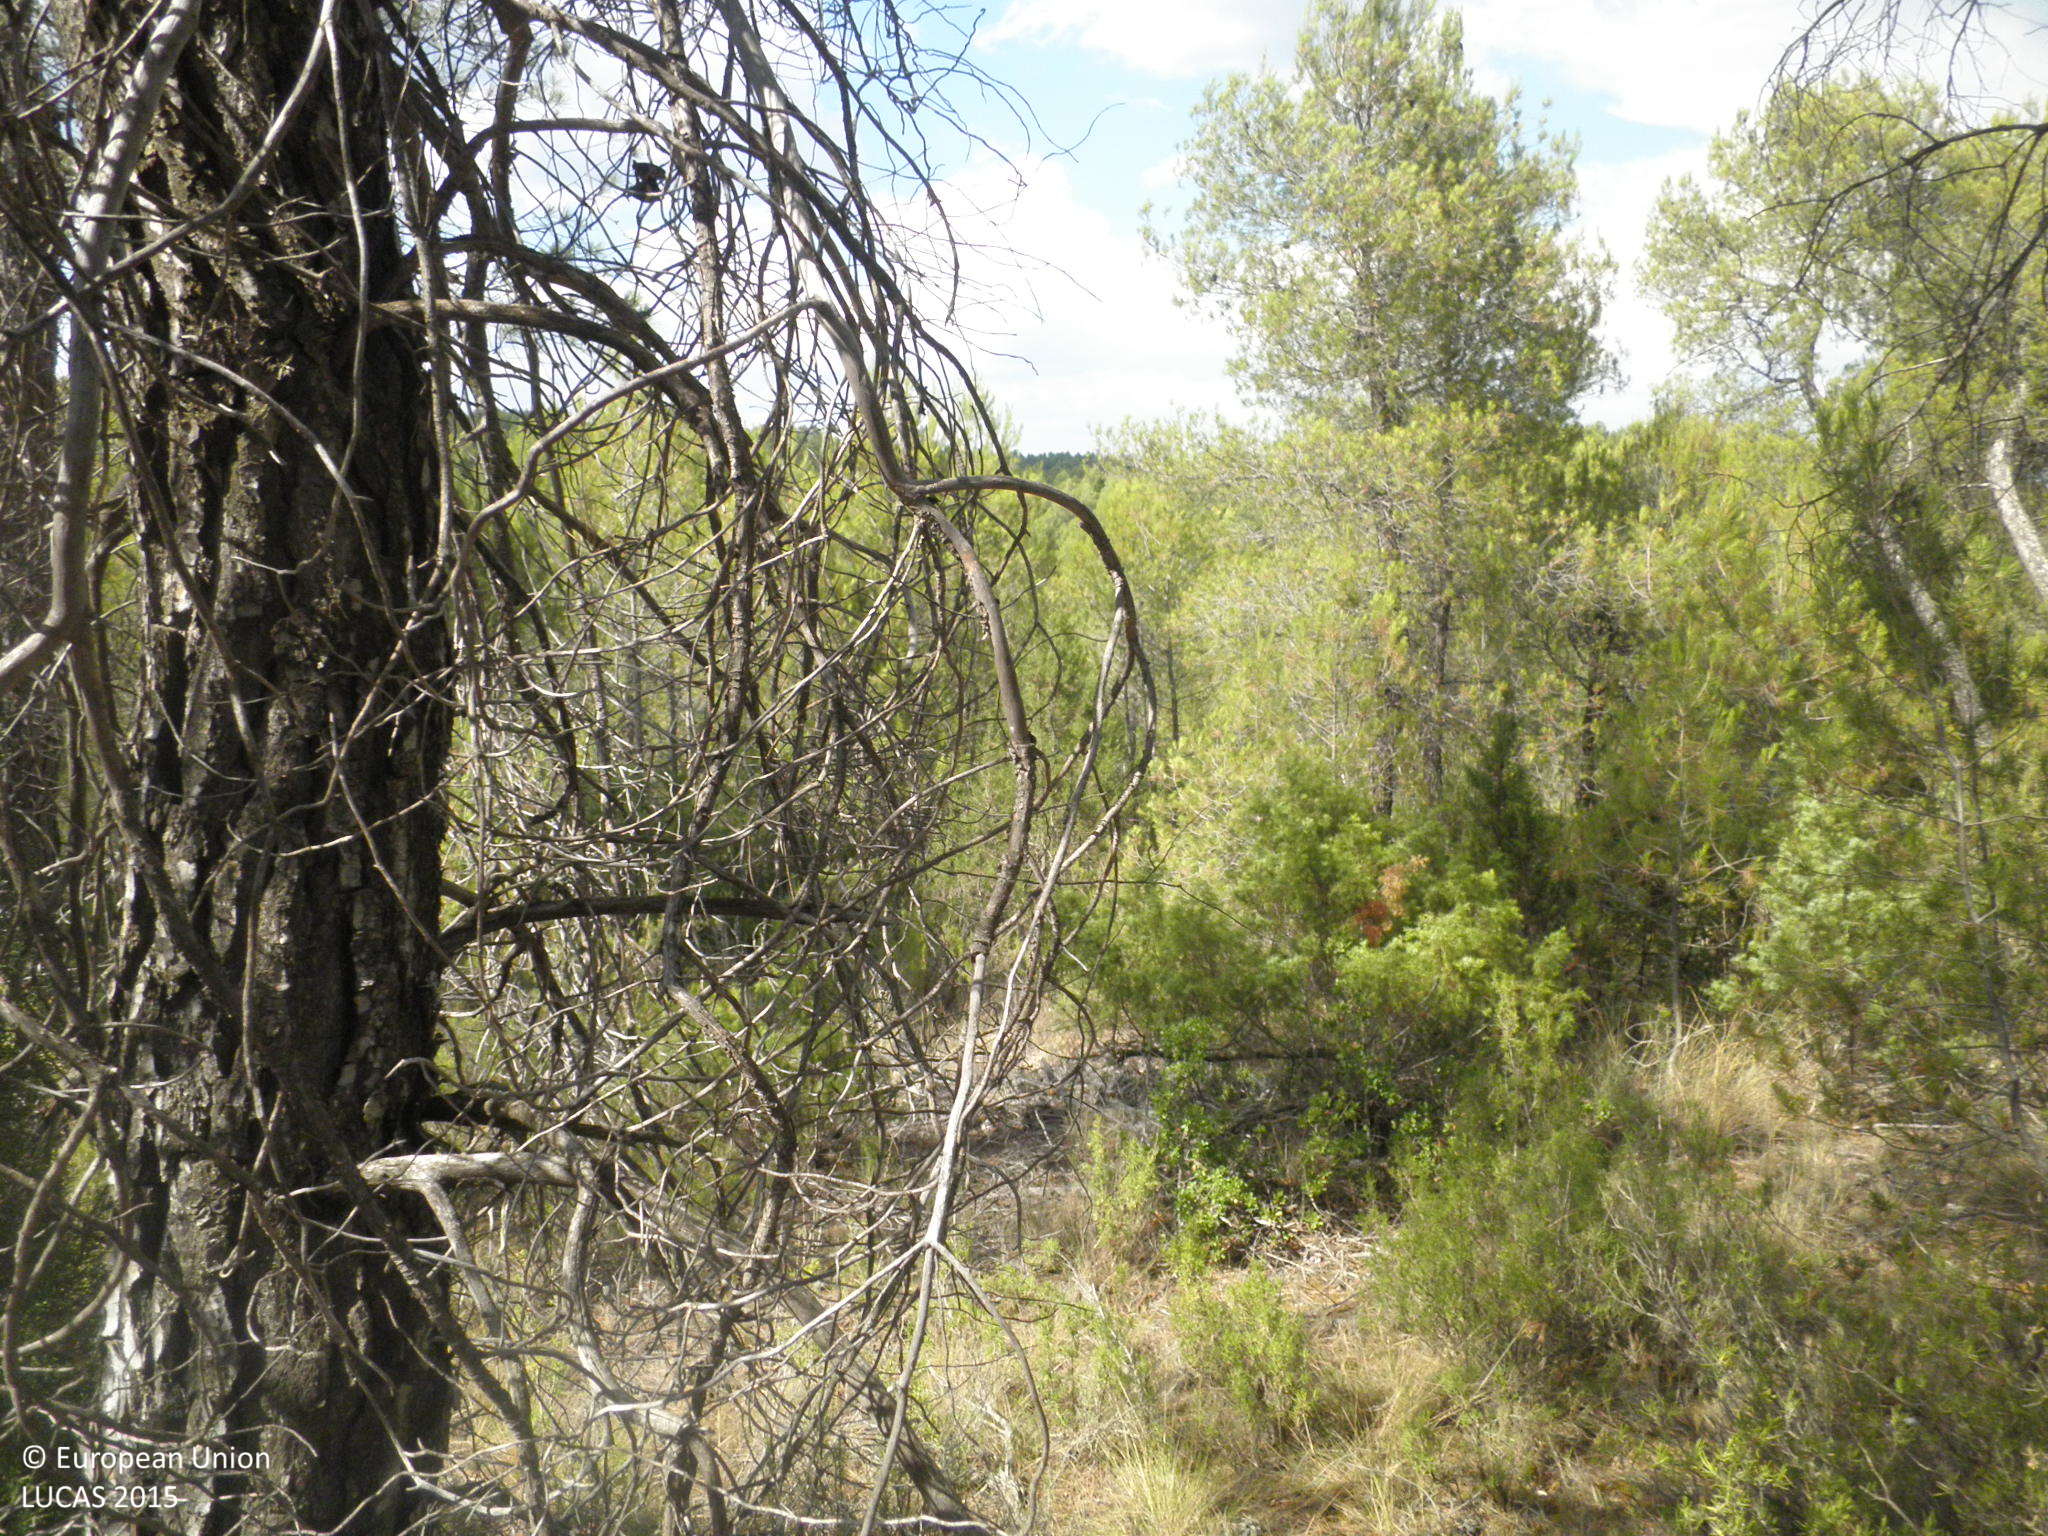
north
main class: Woodland
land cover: Pine dominated coniferous woodland
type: coniferous forest of the mediterranean region
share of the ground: 50 - 75 %
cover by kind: coniferous forest trees 50 %, shrubs 30 %, herbaceous plants 10 %, unconsolidated bare surface 10 %
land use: Semi-natural and natural areas not in use
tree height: > 5 m
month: July
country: ES
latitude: 39.6289
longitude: -1.6219
